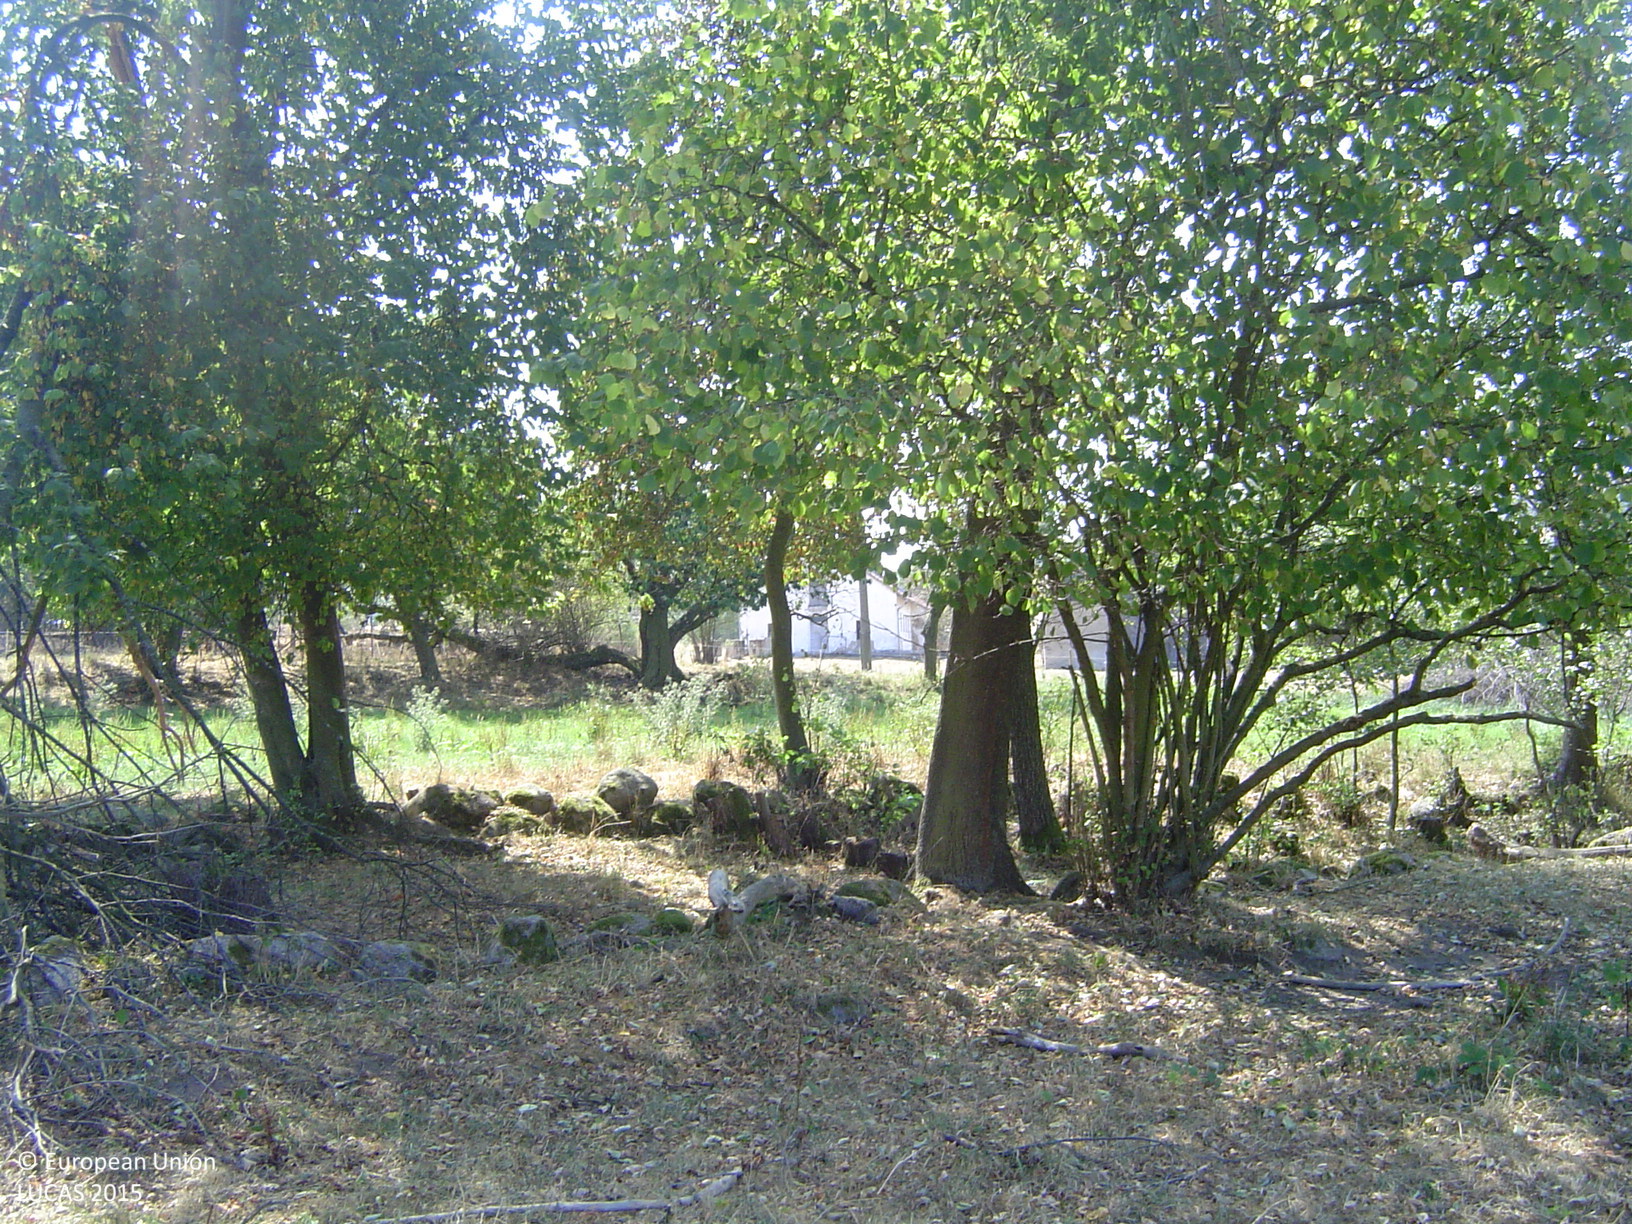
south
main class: Grassland
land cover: Grassland without tree/shrub cover
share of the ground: > 75 %
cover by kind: herbaceous plants 100 %
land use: Agriculture (excluding fallow land and kitchen gardens)
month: August
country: CZ
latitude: 49.5956
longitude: 14.3870
